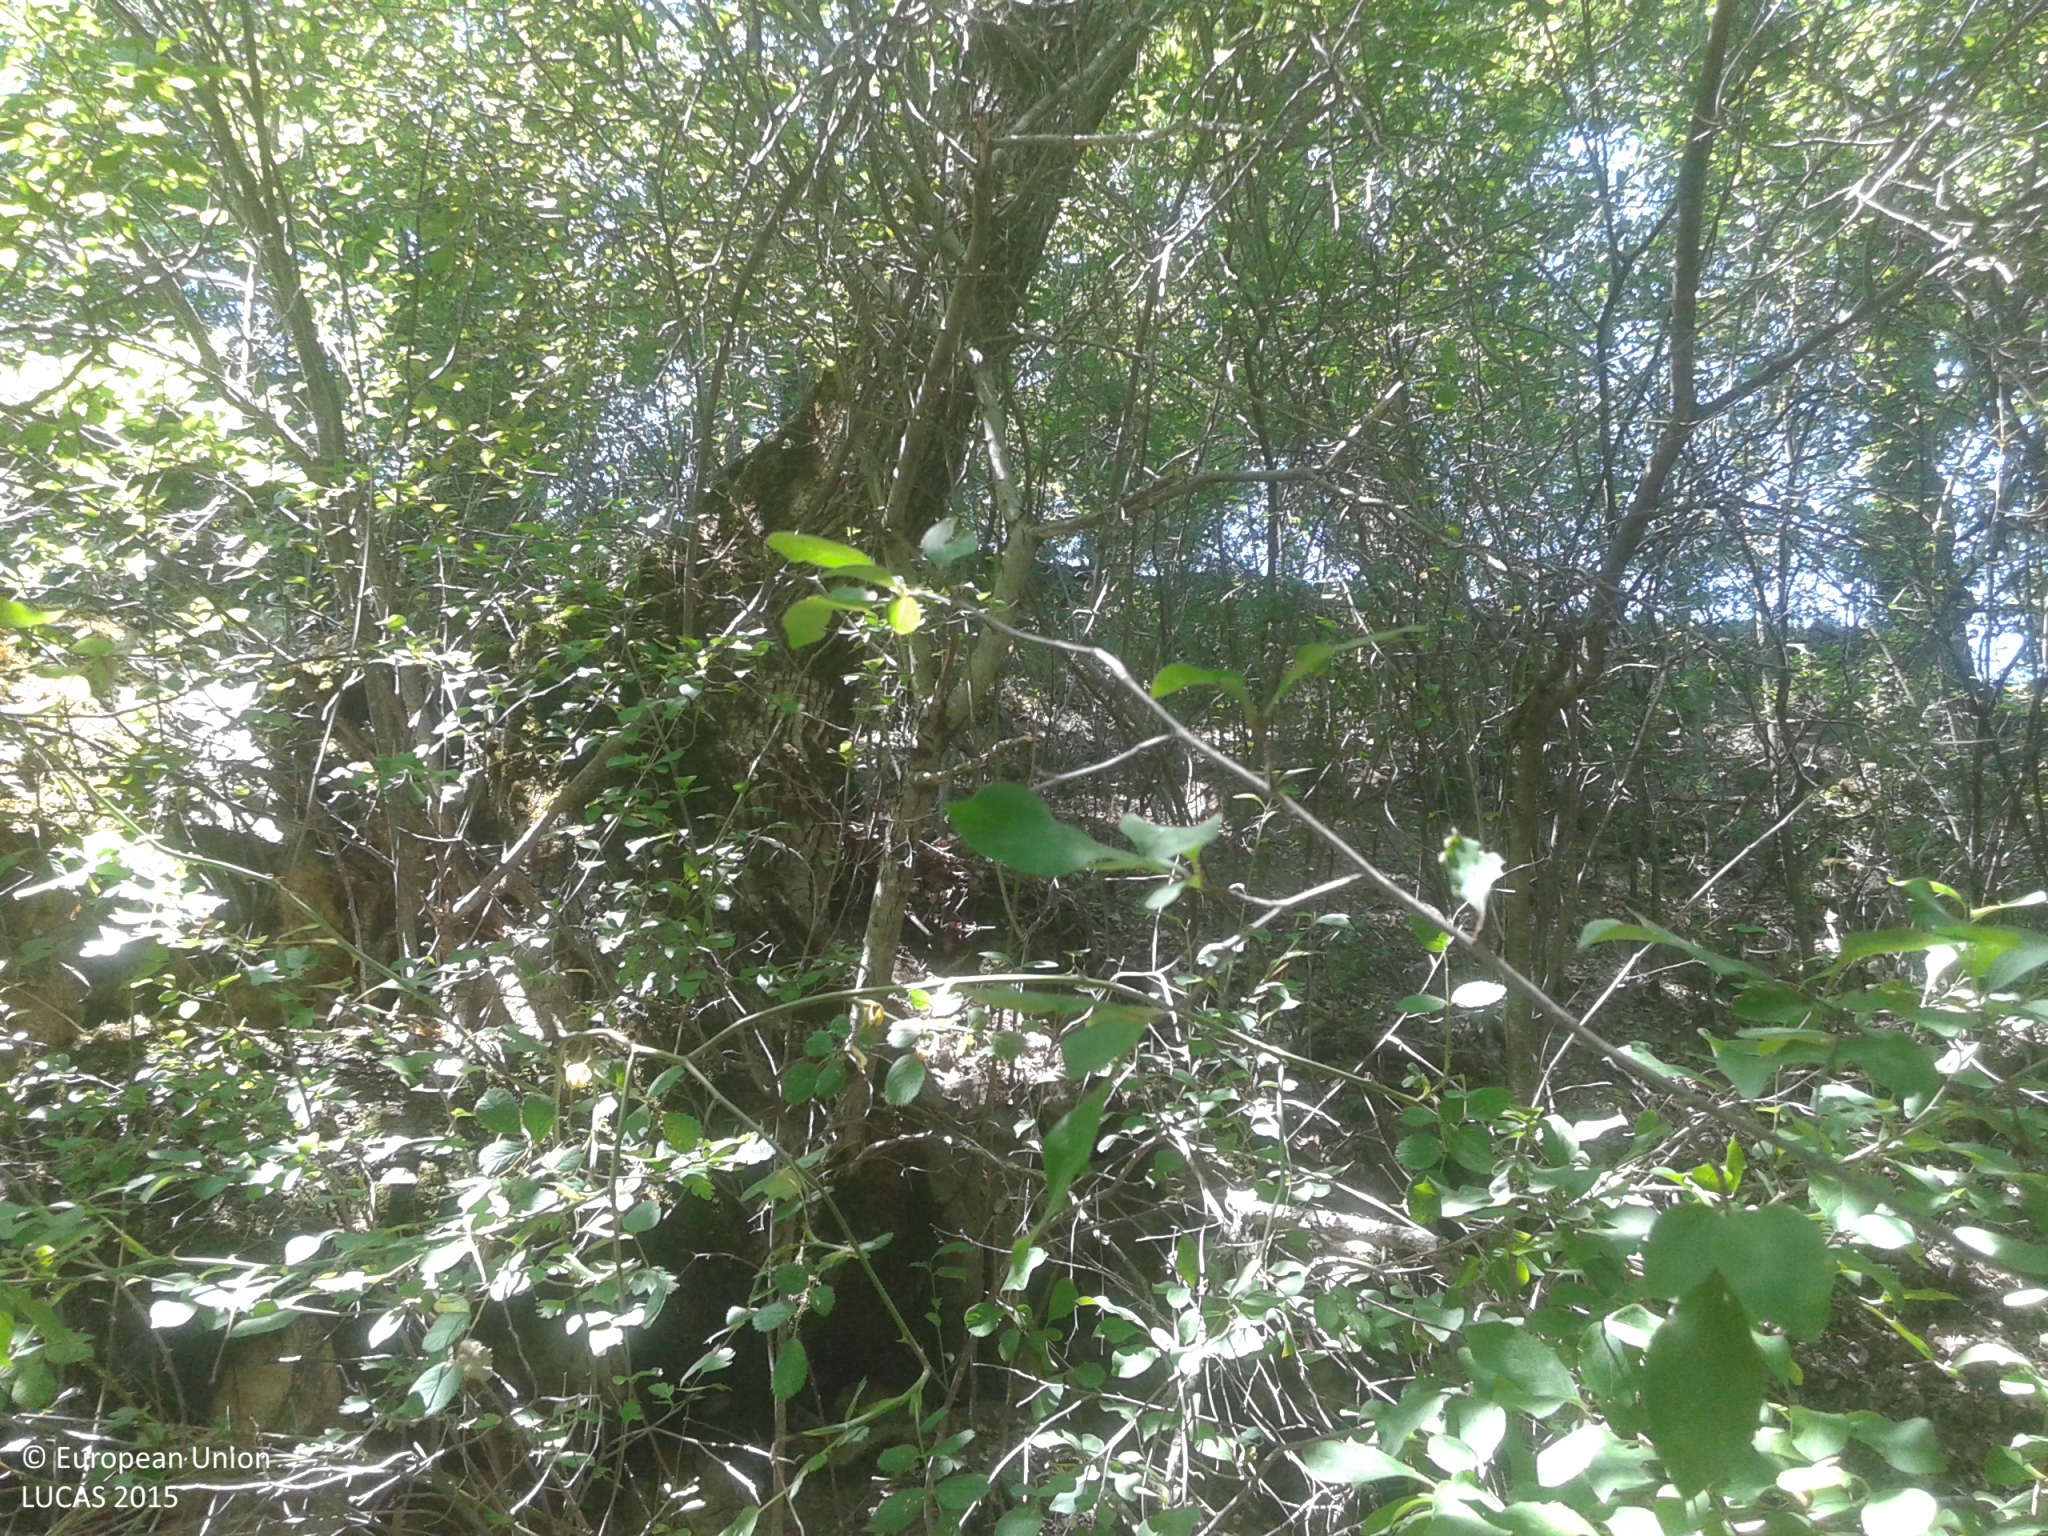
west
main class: Woodland
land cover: Broadleaved woodland
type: thermophilous deciduous forest
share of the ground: > 75 %
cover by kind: broadleaved forest trees 95 %, shrubs 5 %
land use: Semi-natural and natural areas not in use
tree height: > 5 m
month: July
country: ES
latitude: 42.3368
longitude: 1.5510
